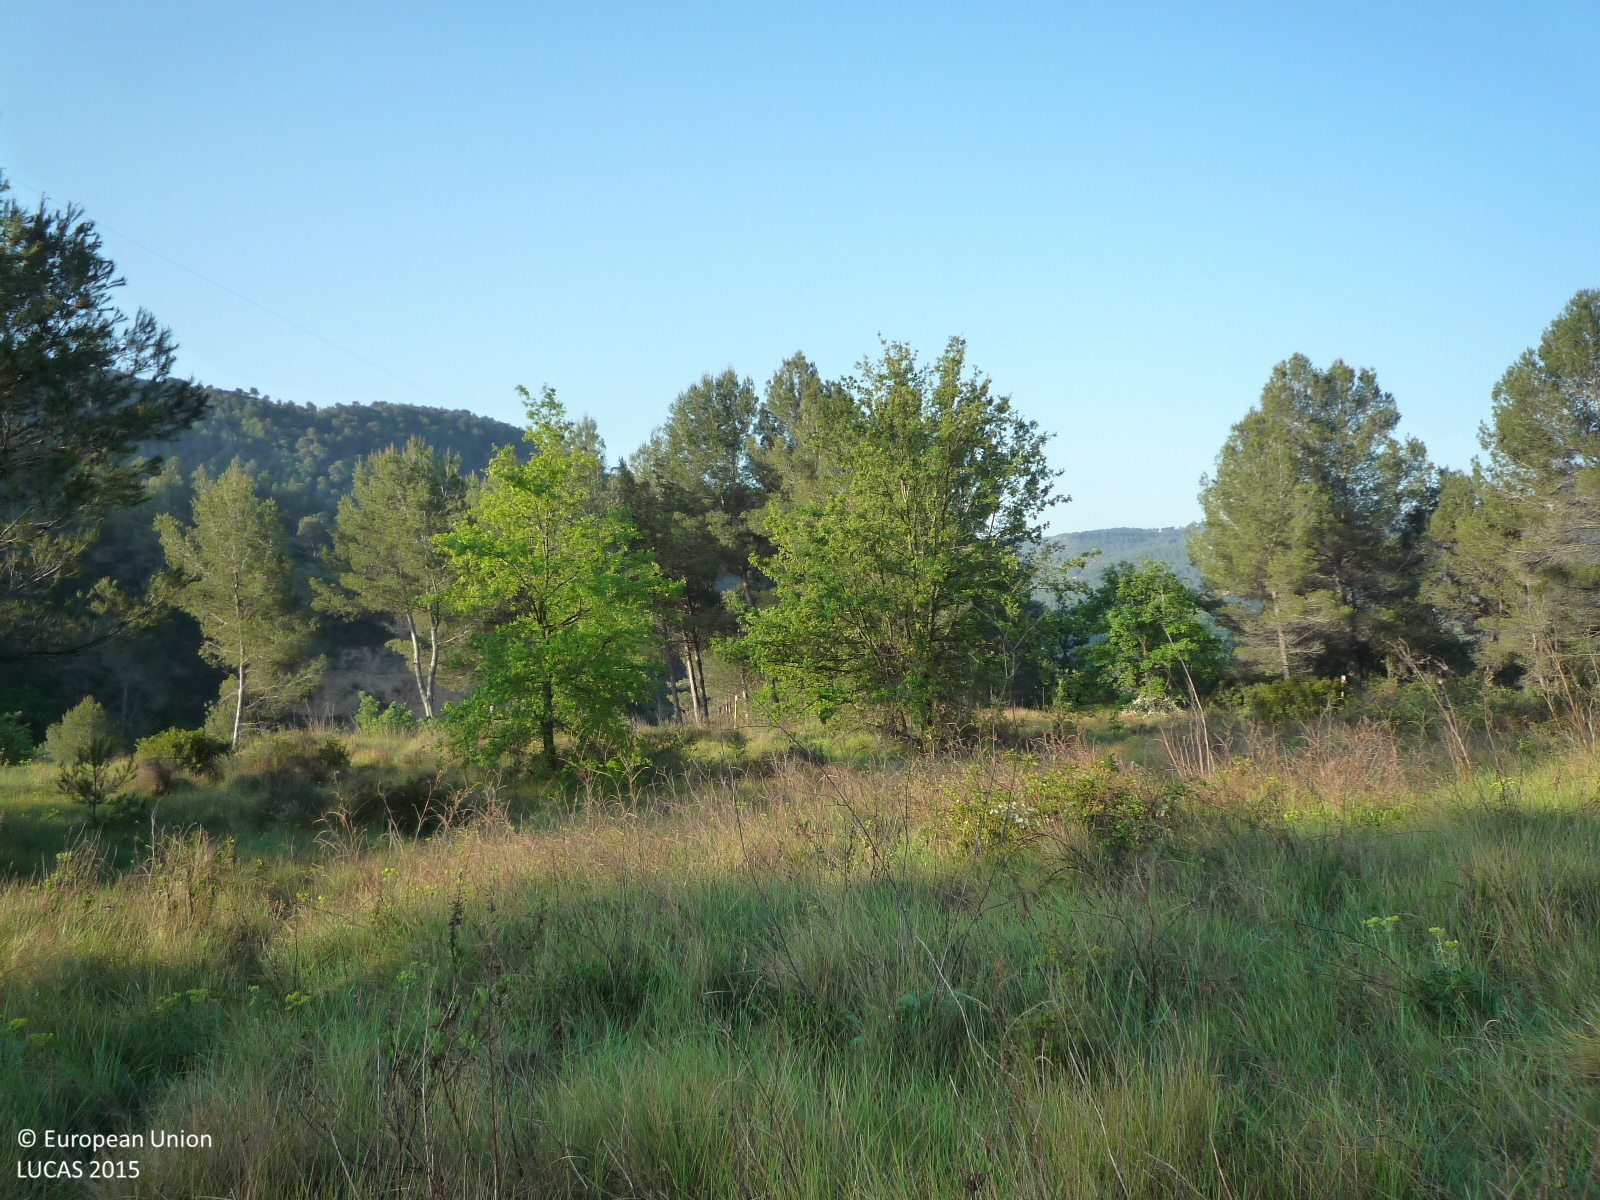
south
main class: Grassland
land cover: Grassland with sparse tree/shrub cover
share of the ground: > 75 %
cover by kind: herbaceous plants 90 %, coniferous forest trees 5 %, shrubs 5 %
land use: Abandoned areas
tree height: > 5 m
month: April
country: ES
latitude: 41.5152
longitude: 1.7126
